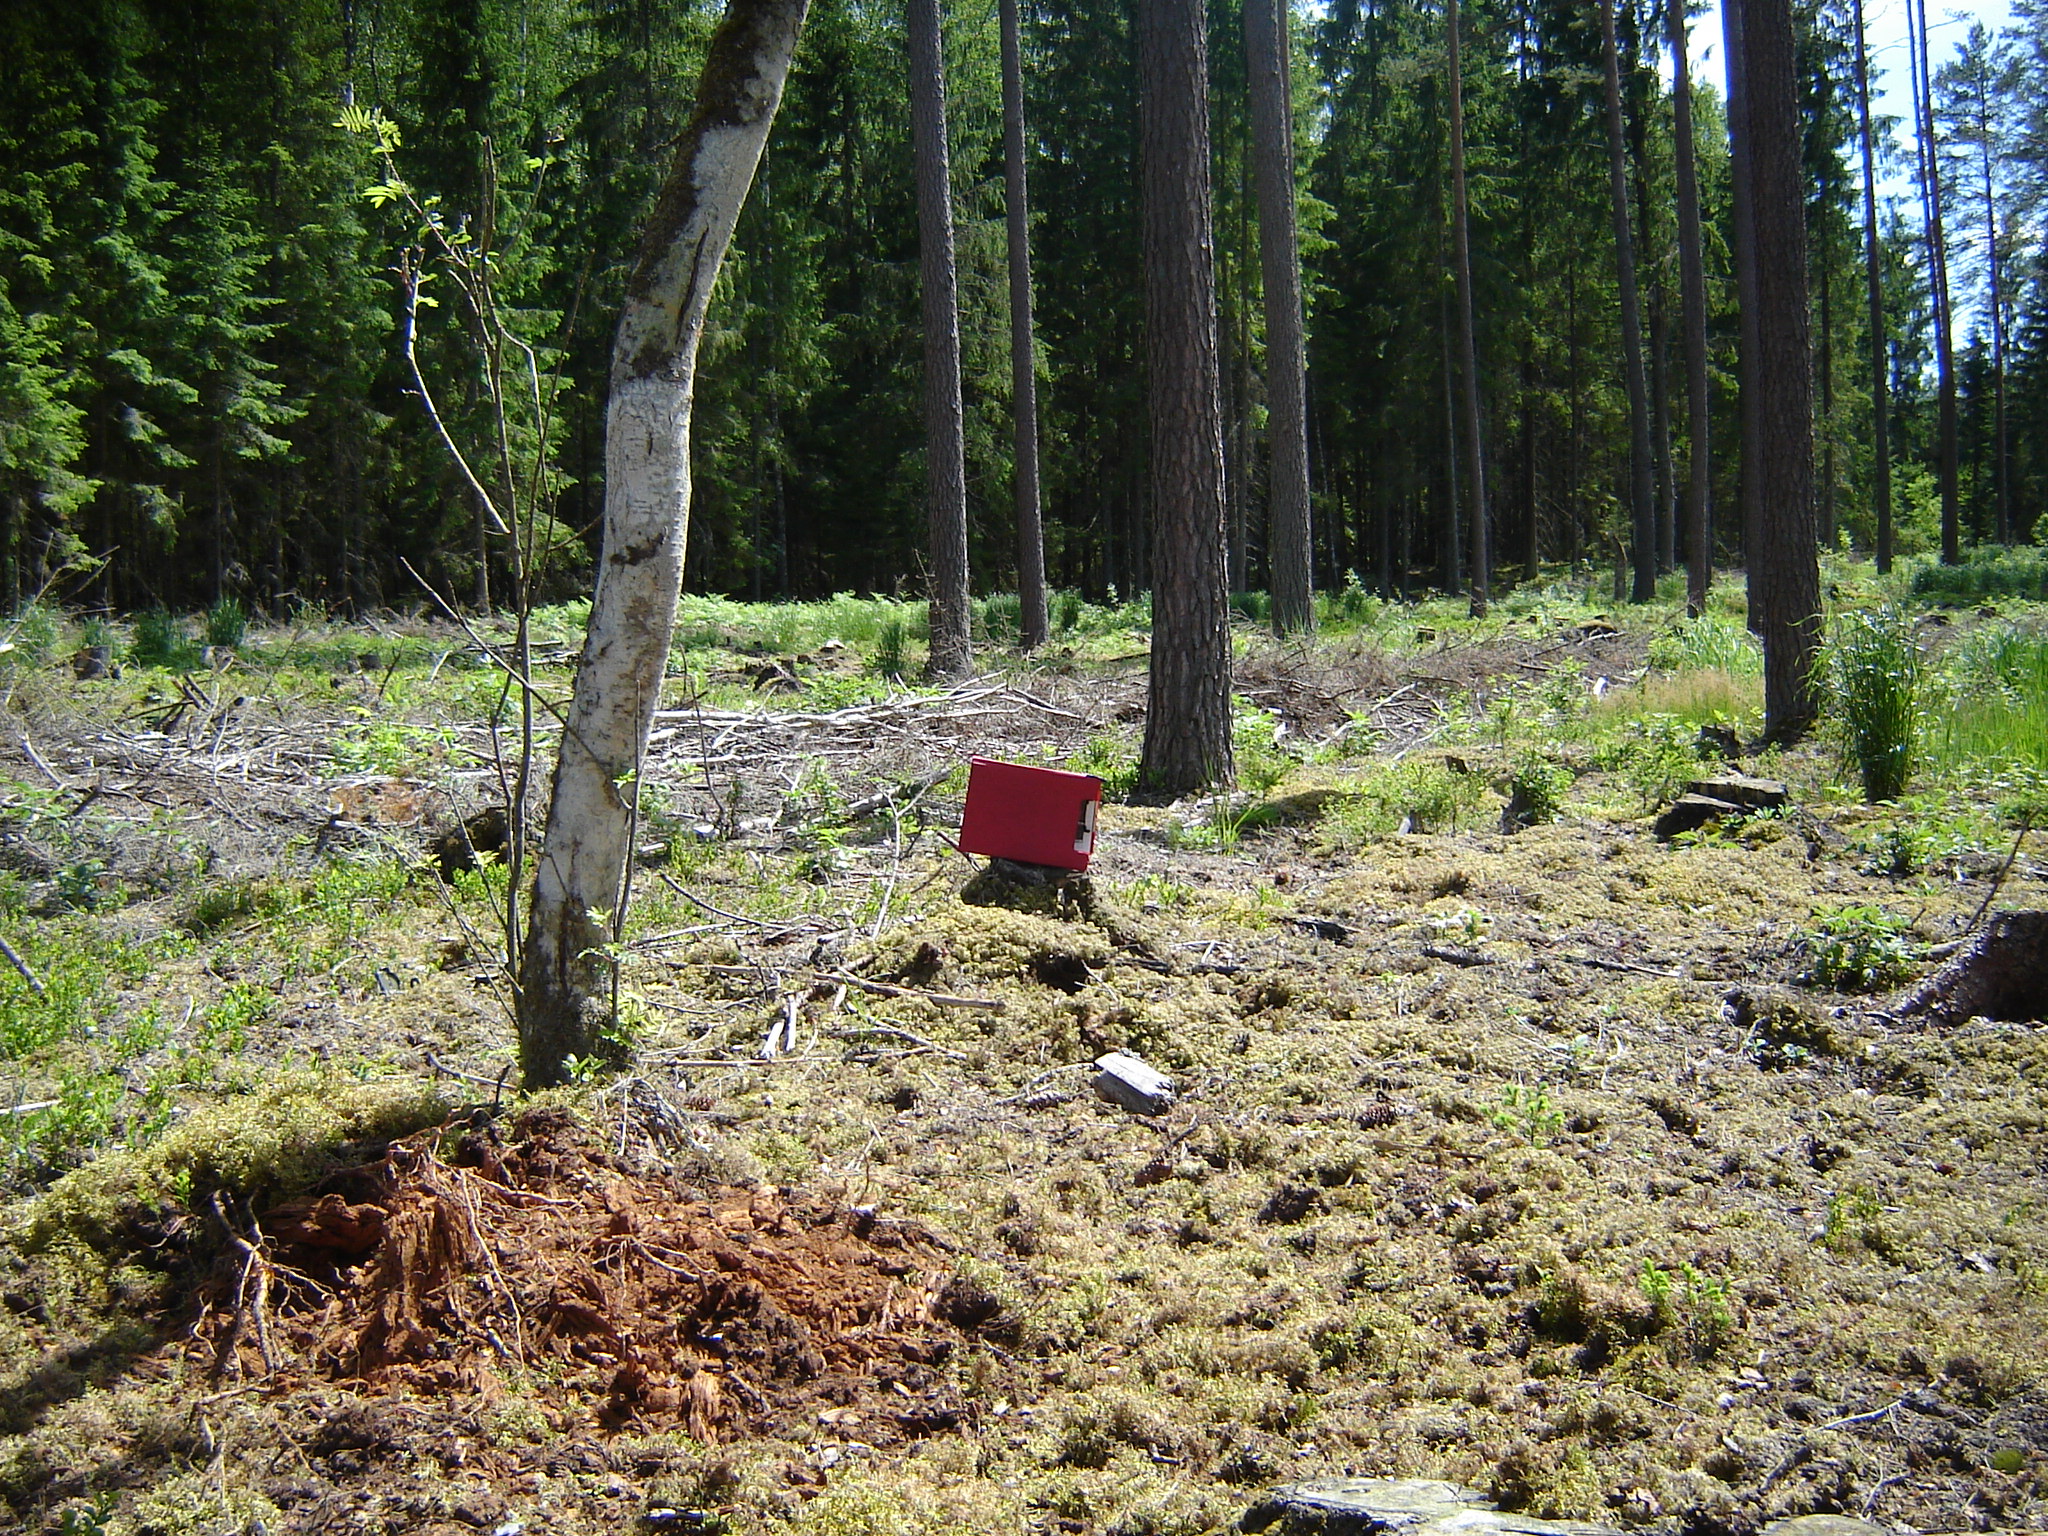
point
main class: Woodland
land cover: Pine dominated coniferous woodland
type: hemiboreal forest and nemoral coniferous forest and mixed broadleaved-coniferous forest
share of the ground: 50 - 75 %
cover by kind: coniferous forest trees 50 %, lichens and mosses 30 %, shrubs 10 %, herbaceous plants 10 %
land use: Forestry
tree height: > 5 m
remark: Clear cut
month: June
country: LT
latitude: 55.6807
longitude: 25.1763
